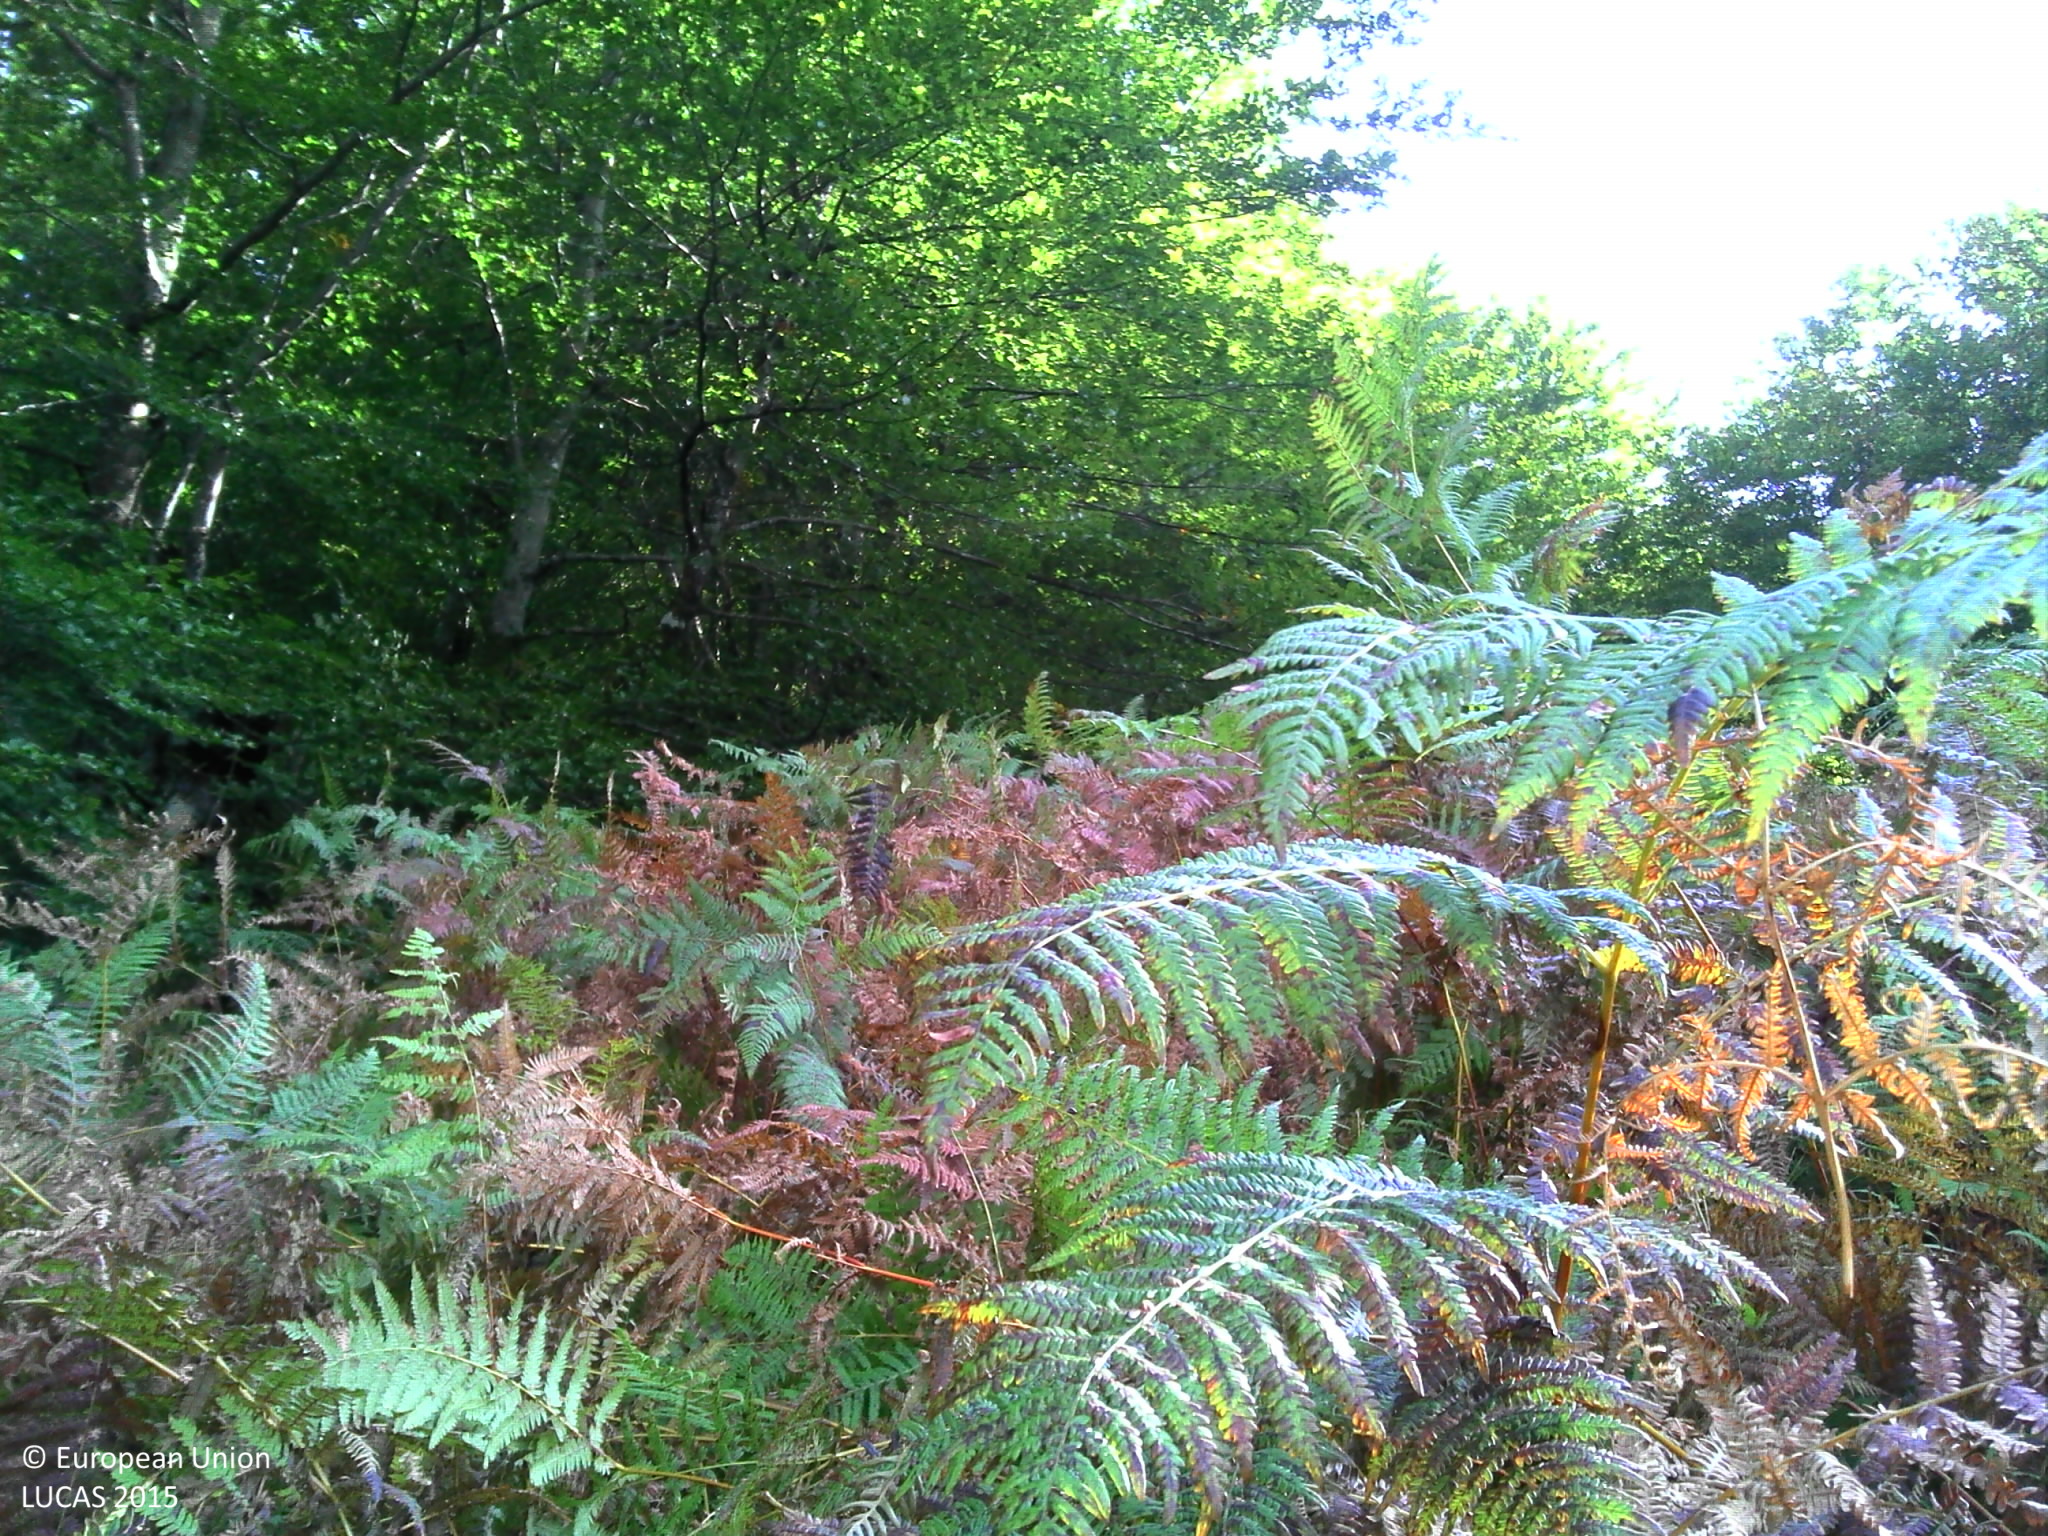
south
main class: Grassland
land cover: Spontaneously vegetated surfaces
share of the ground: > 75 %
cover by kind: herbaceous plants 95 %, shrubs 5 %
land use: Abandoned areas
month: September
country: FR
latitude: 43.0373
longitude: -0.6488
